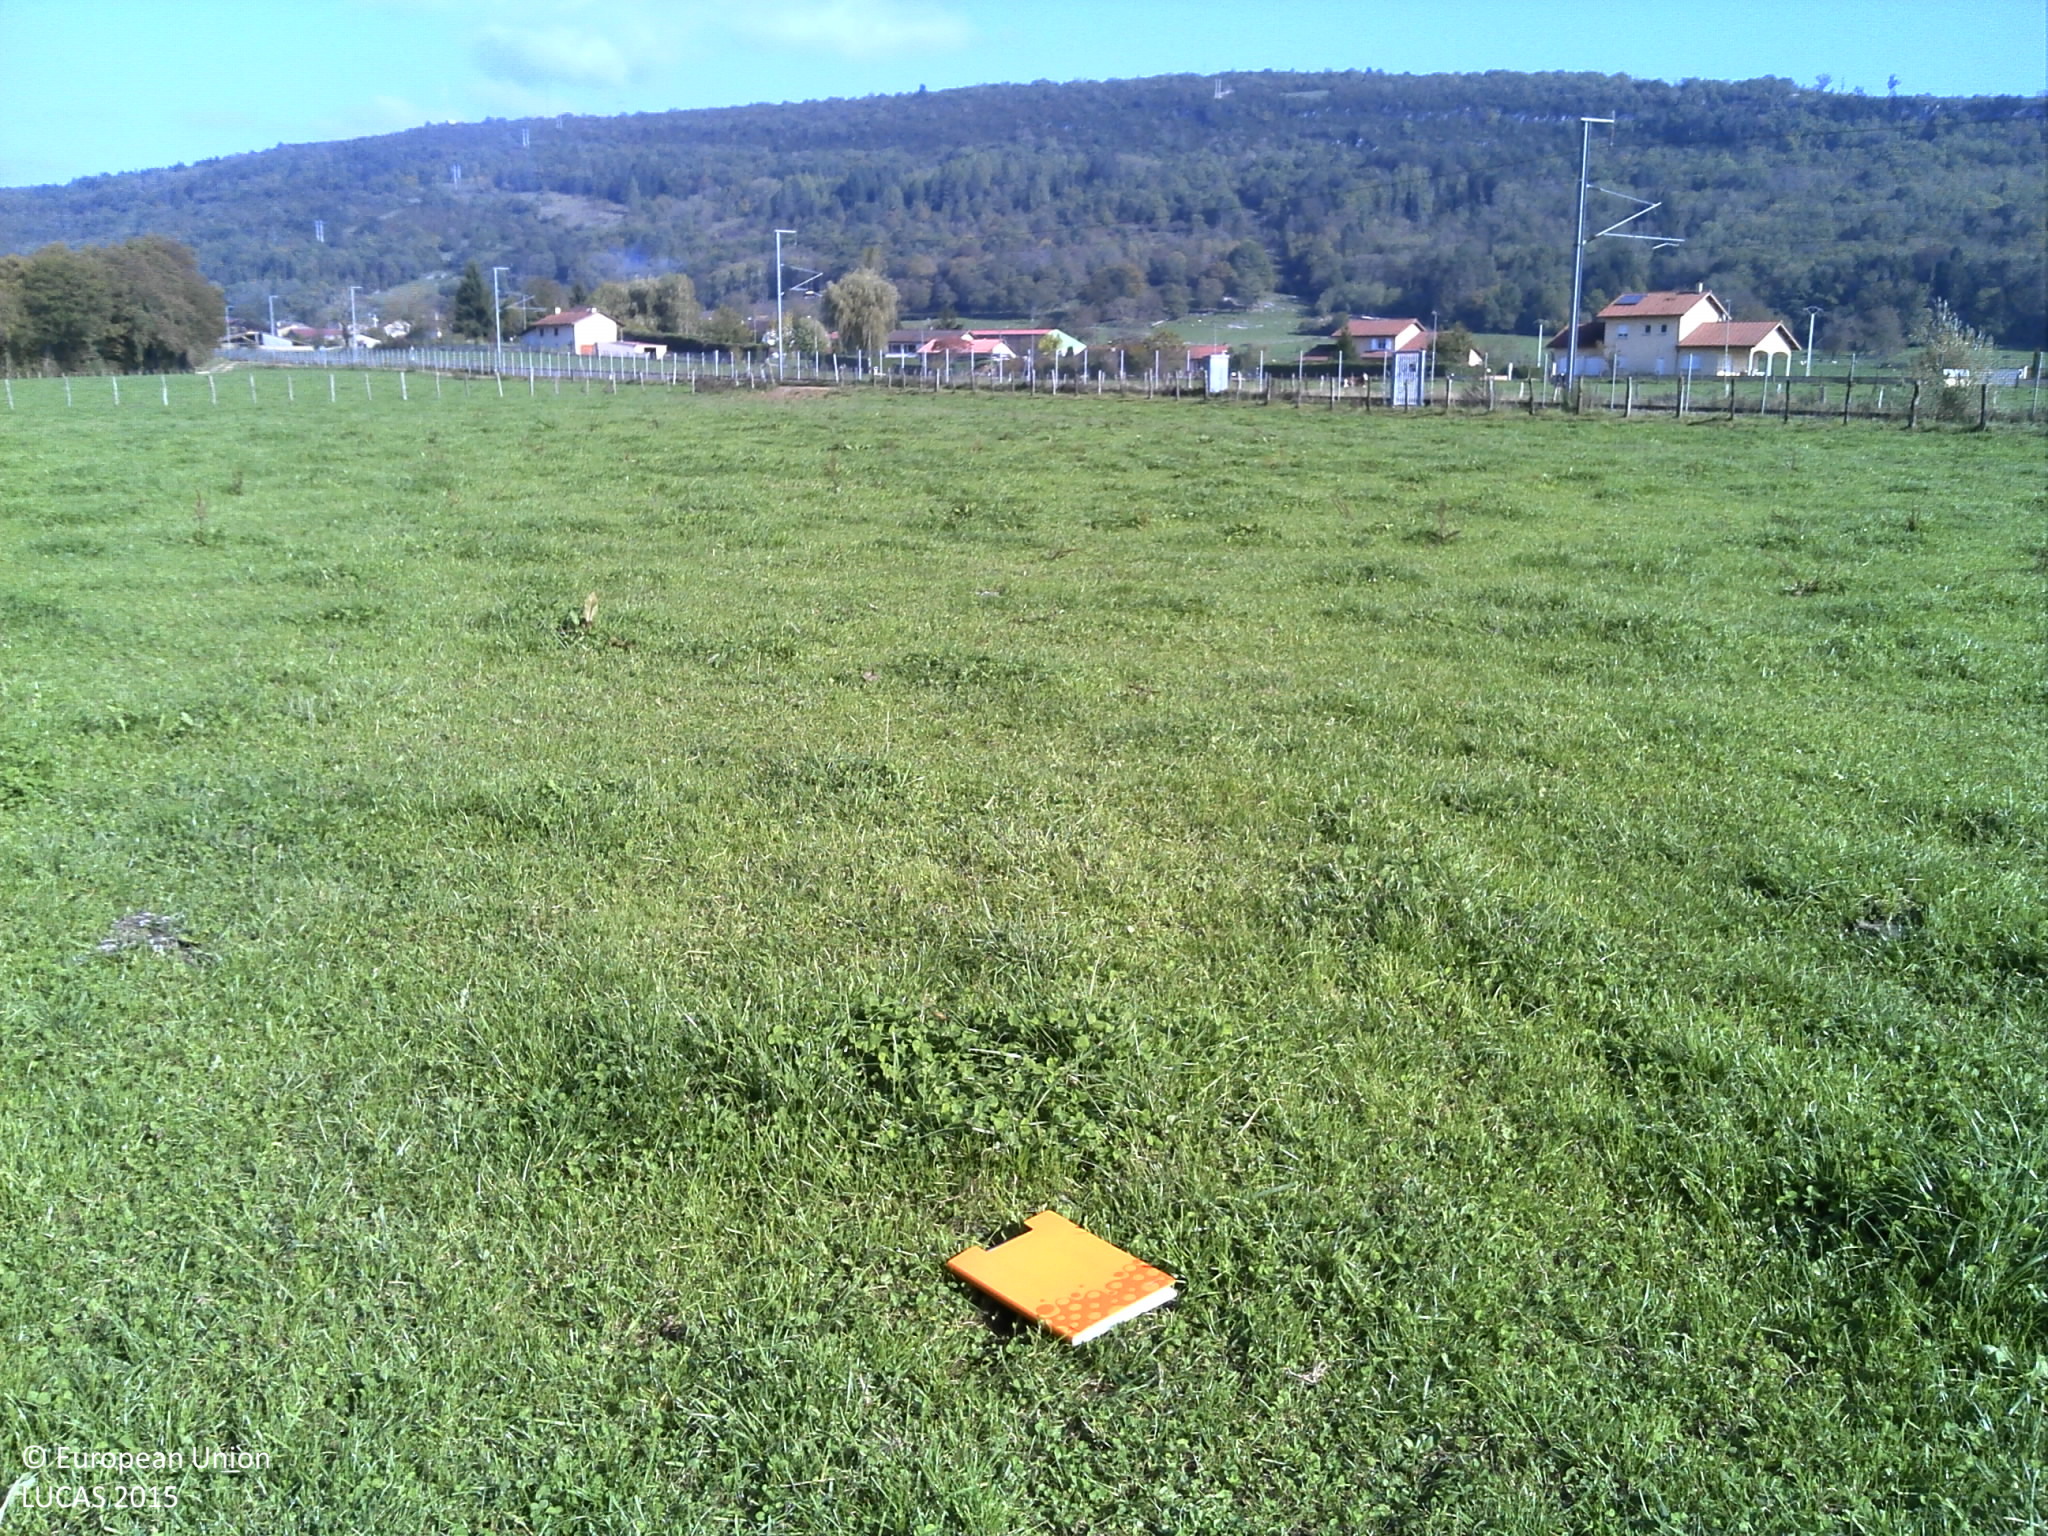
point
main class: Grassland
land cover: Grassland without tree/shrub cover
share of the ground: > 75 %
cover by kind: herbaceous plants 100 %
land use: Agriculture (excluding fallow land and kitchen gardens)
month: October
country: FR
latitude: 46.1983
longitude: 5.4028
